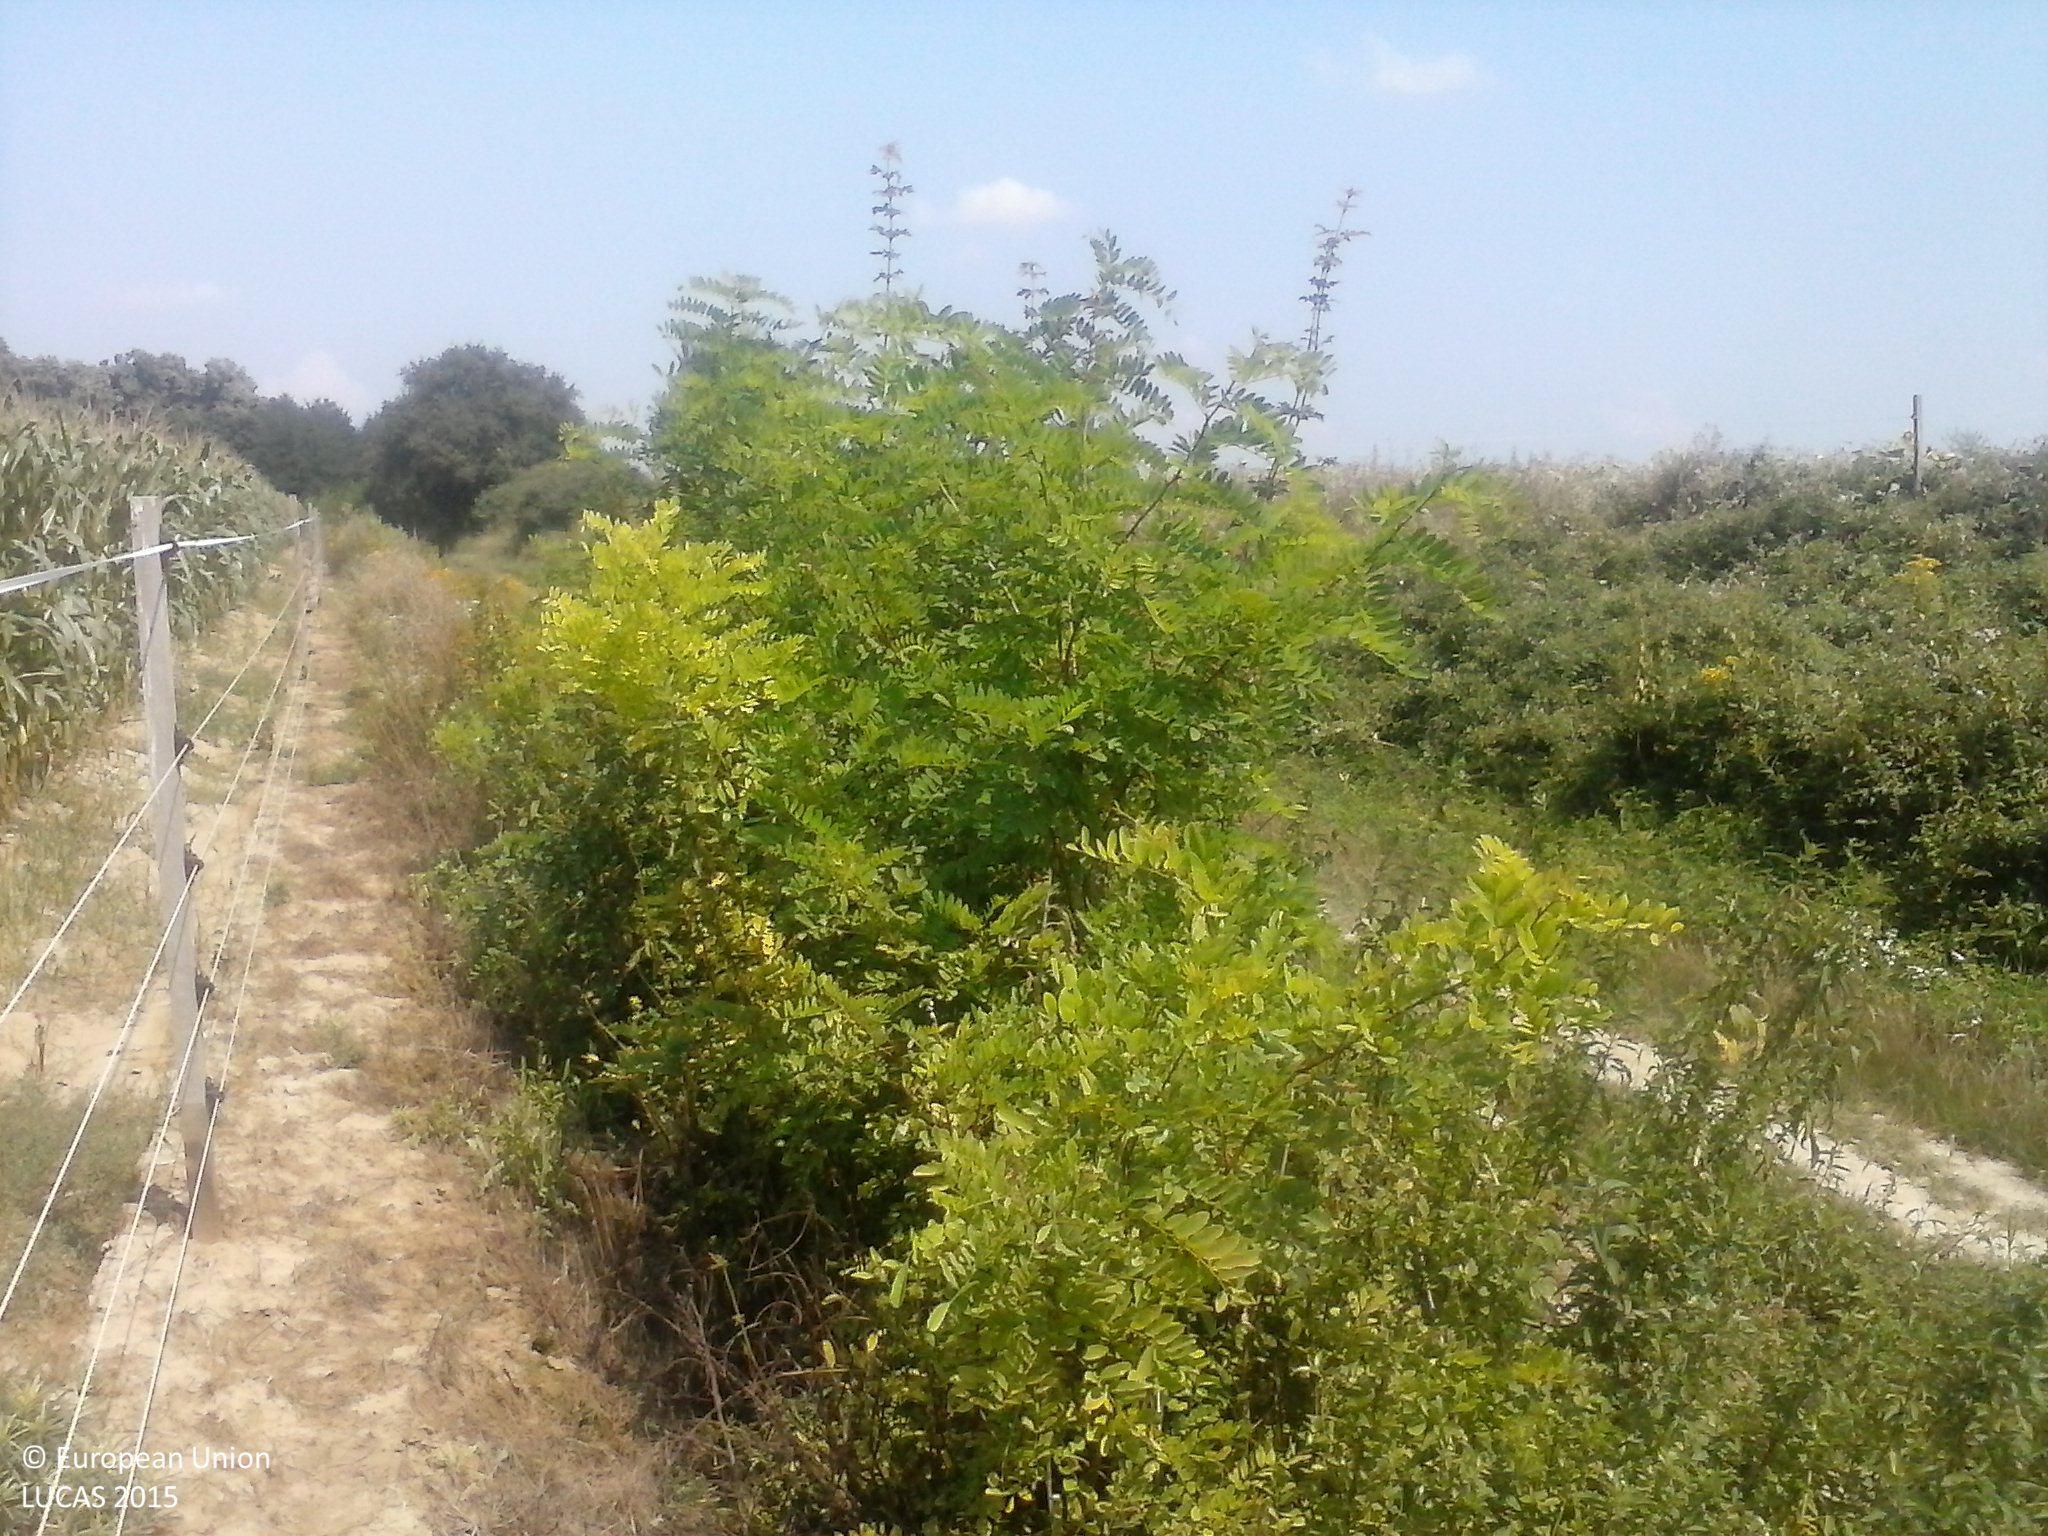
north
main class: Cropland
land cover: Maize
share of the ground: > 75 %
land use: Agriculture (excluding fallow land and kitchen gardens)
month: August
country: HU
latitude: 46.1697
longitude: 17.8675
